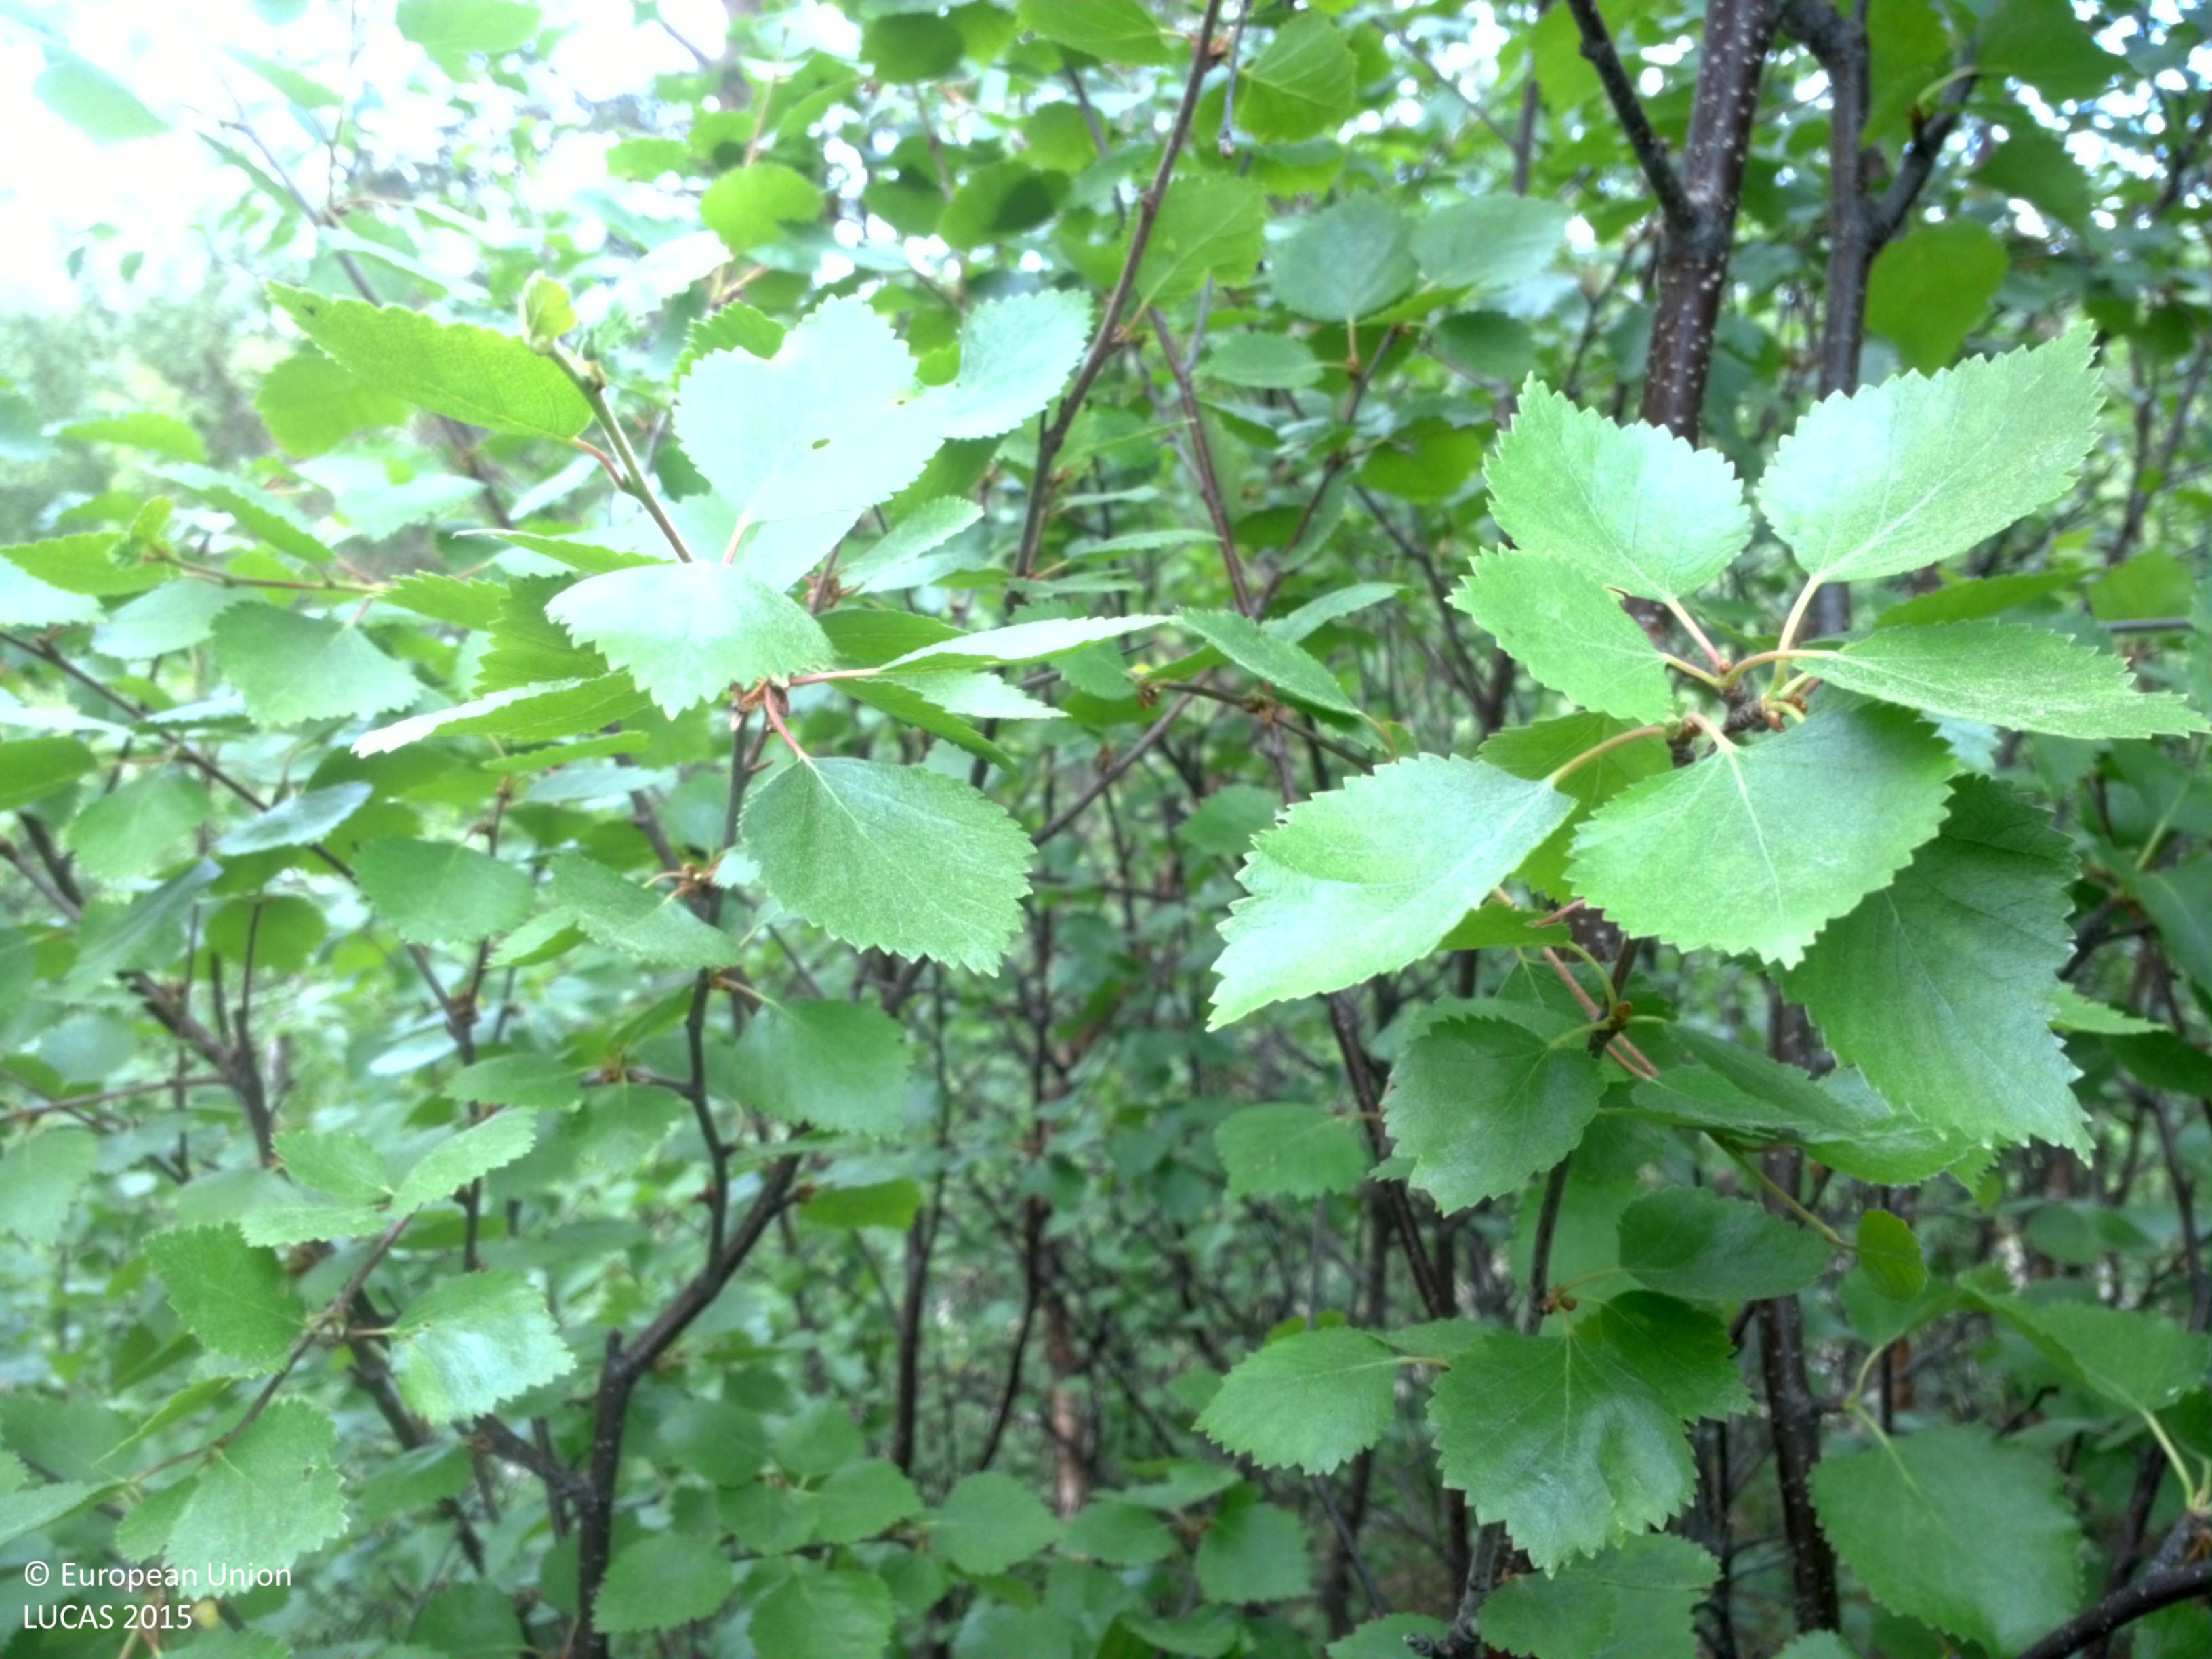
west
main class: Woodland
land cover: Broadleaved woodland
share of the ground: > 75 %
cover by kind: broadleaved forest trees 90 %, coniferous forest trees 5 %, shrubs 5 %
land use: Forestry
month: July
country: SE
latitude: 67.5050
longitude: 18.4433
